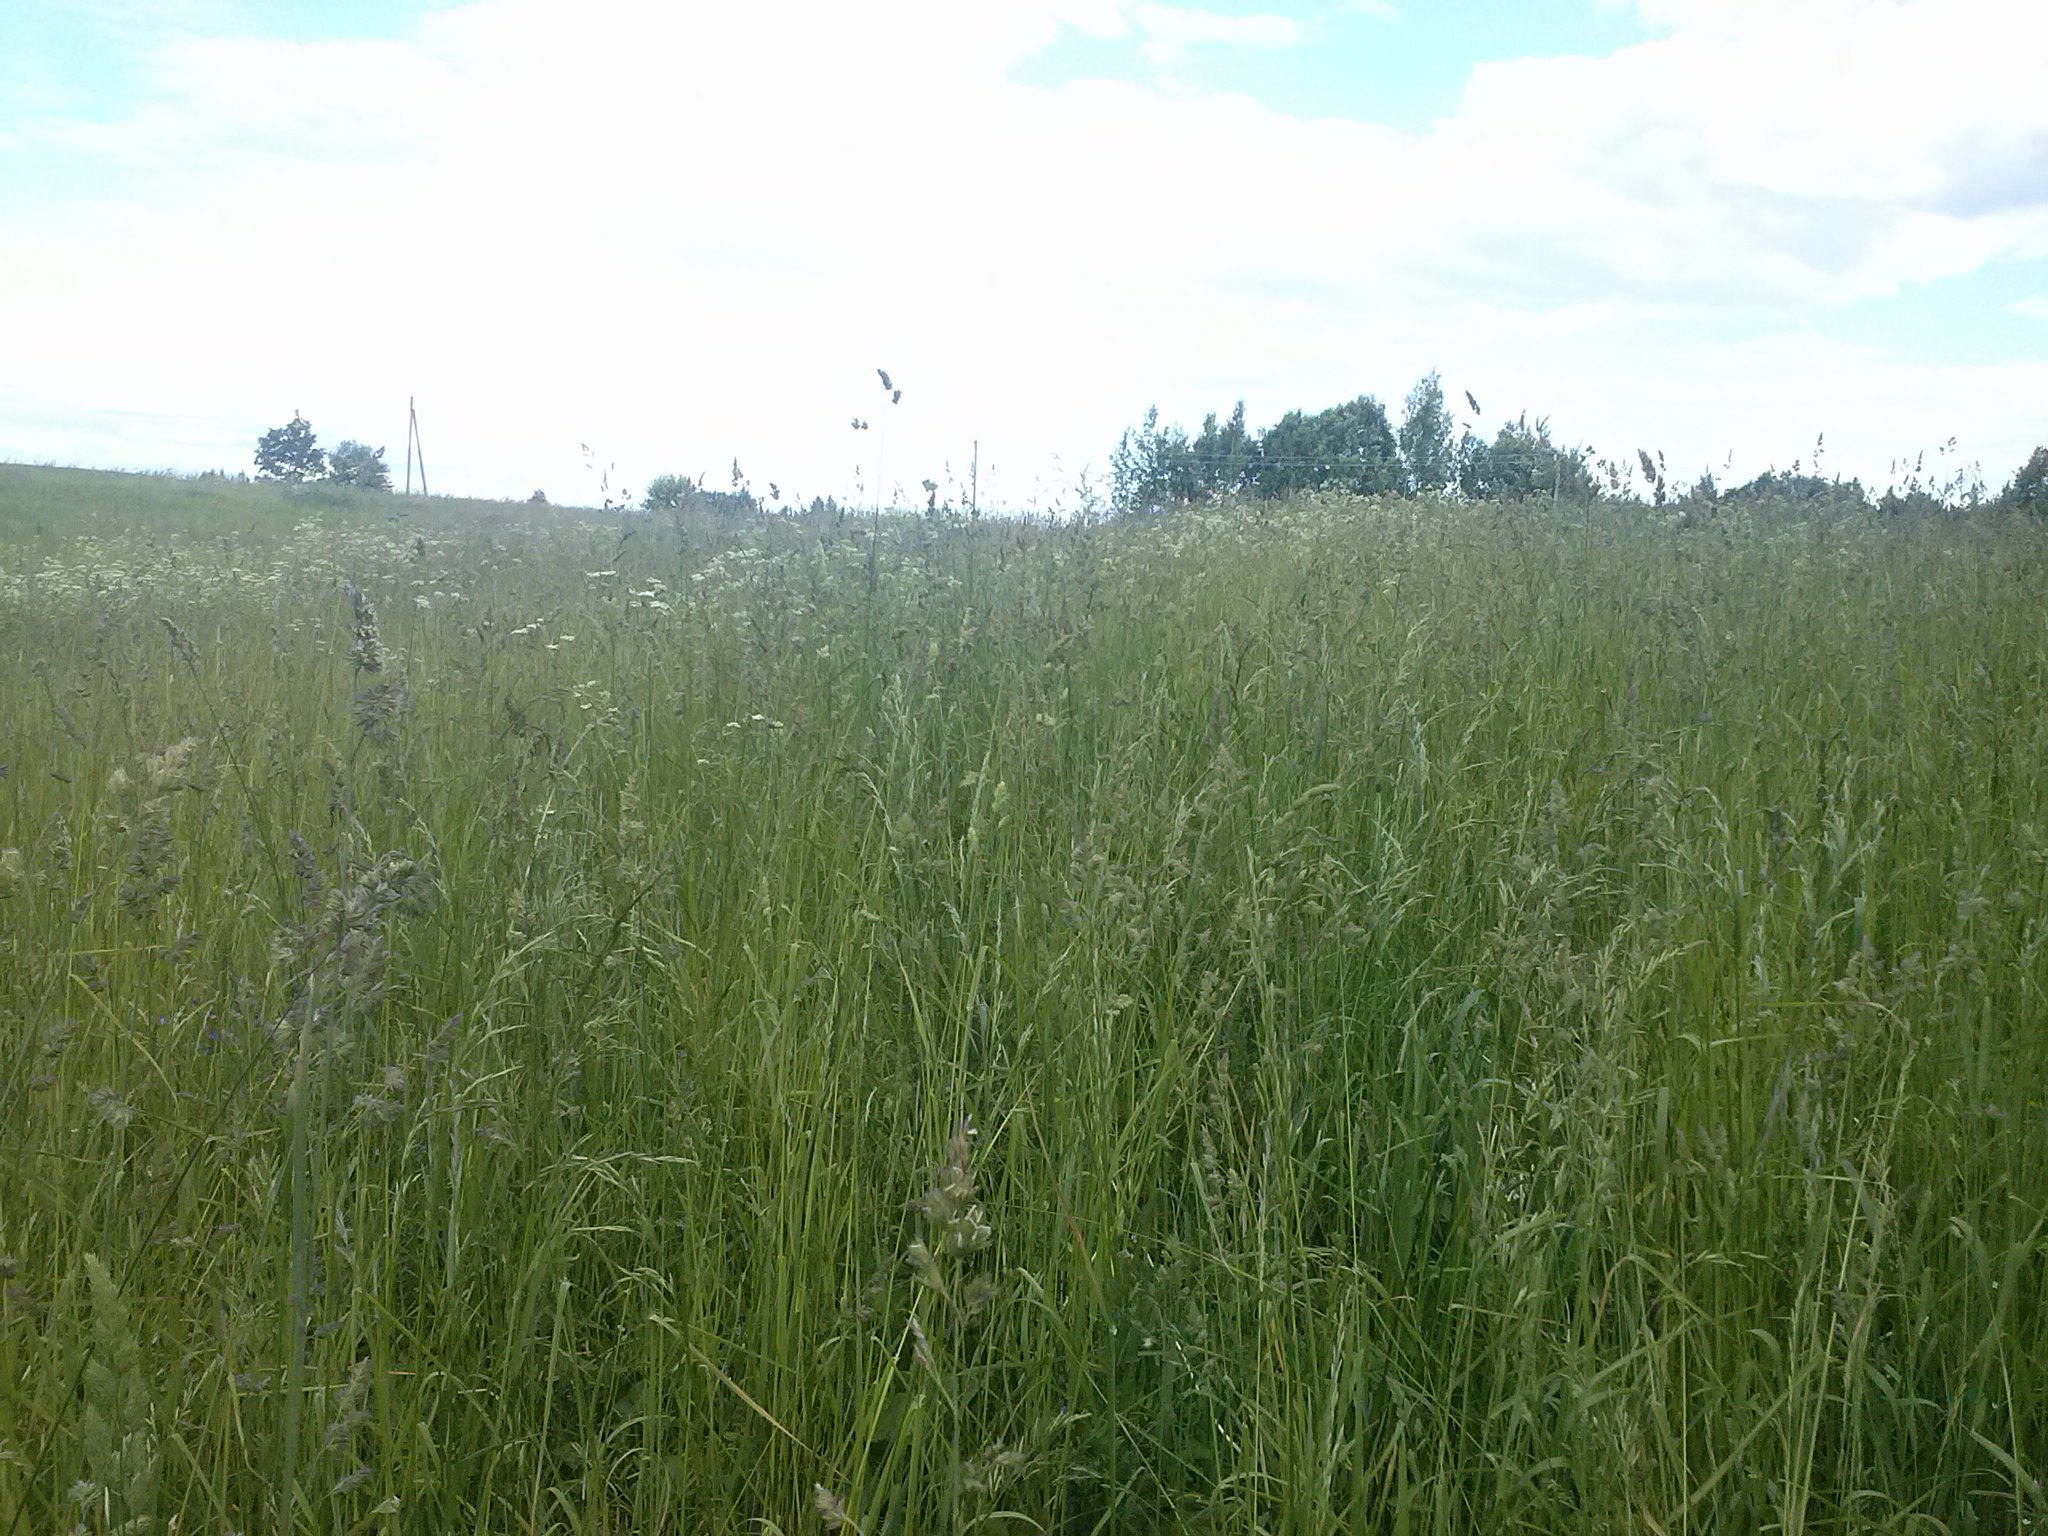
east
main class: Grassland
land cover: Grassland without tree/shrub cover
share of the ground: > 75 %
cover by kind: herbaceous plants 100 %
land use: Agriculture (excluding fallow land and kitchen gardens)
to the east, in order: Grassland without tree/shrub cover; Electric lines; Spontaneously vegetated surfaces; Paved roads, cycling and walking lanes; Grassland without tree/shrub cover
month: June
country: LV
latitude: 56.5003
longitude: 27.7827
